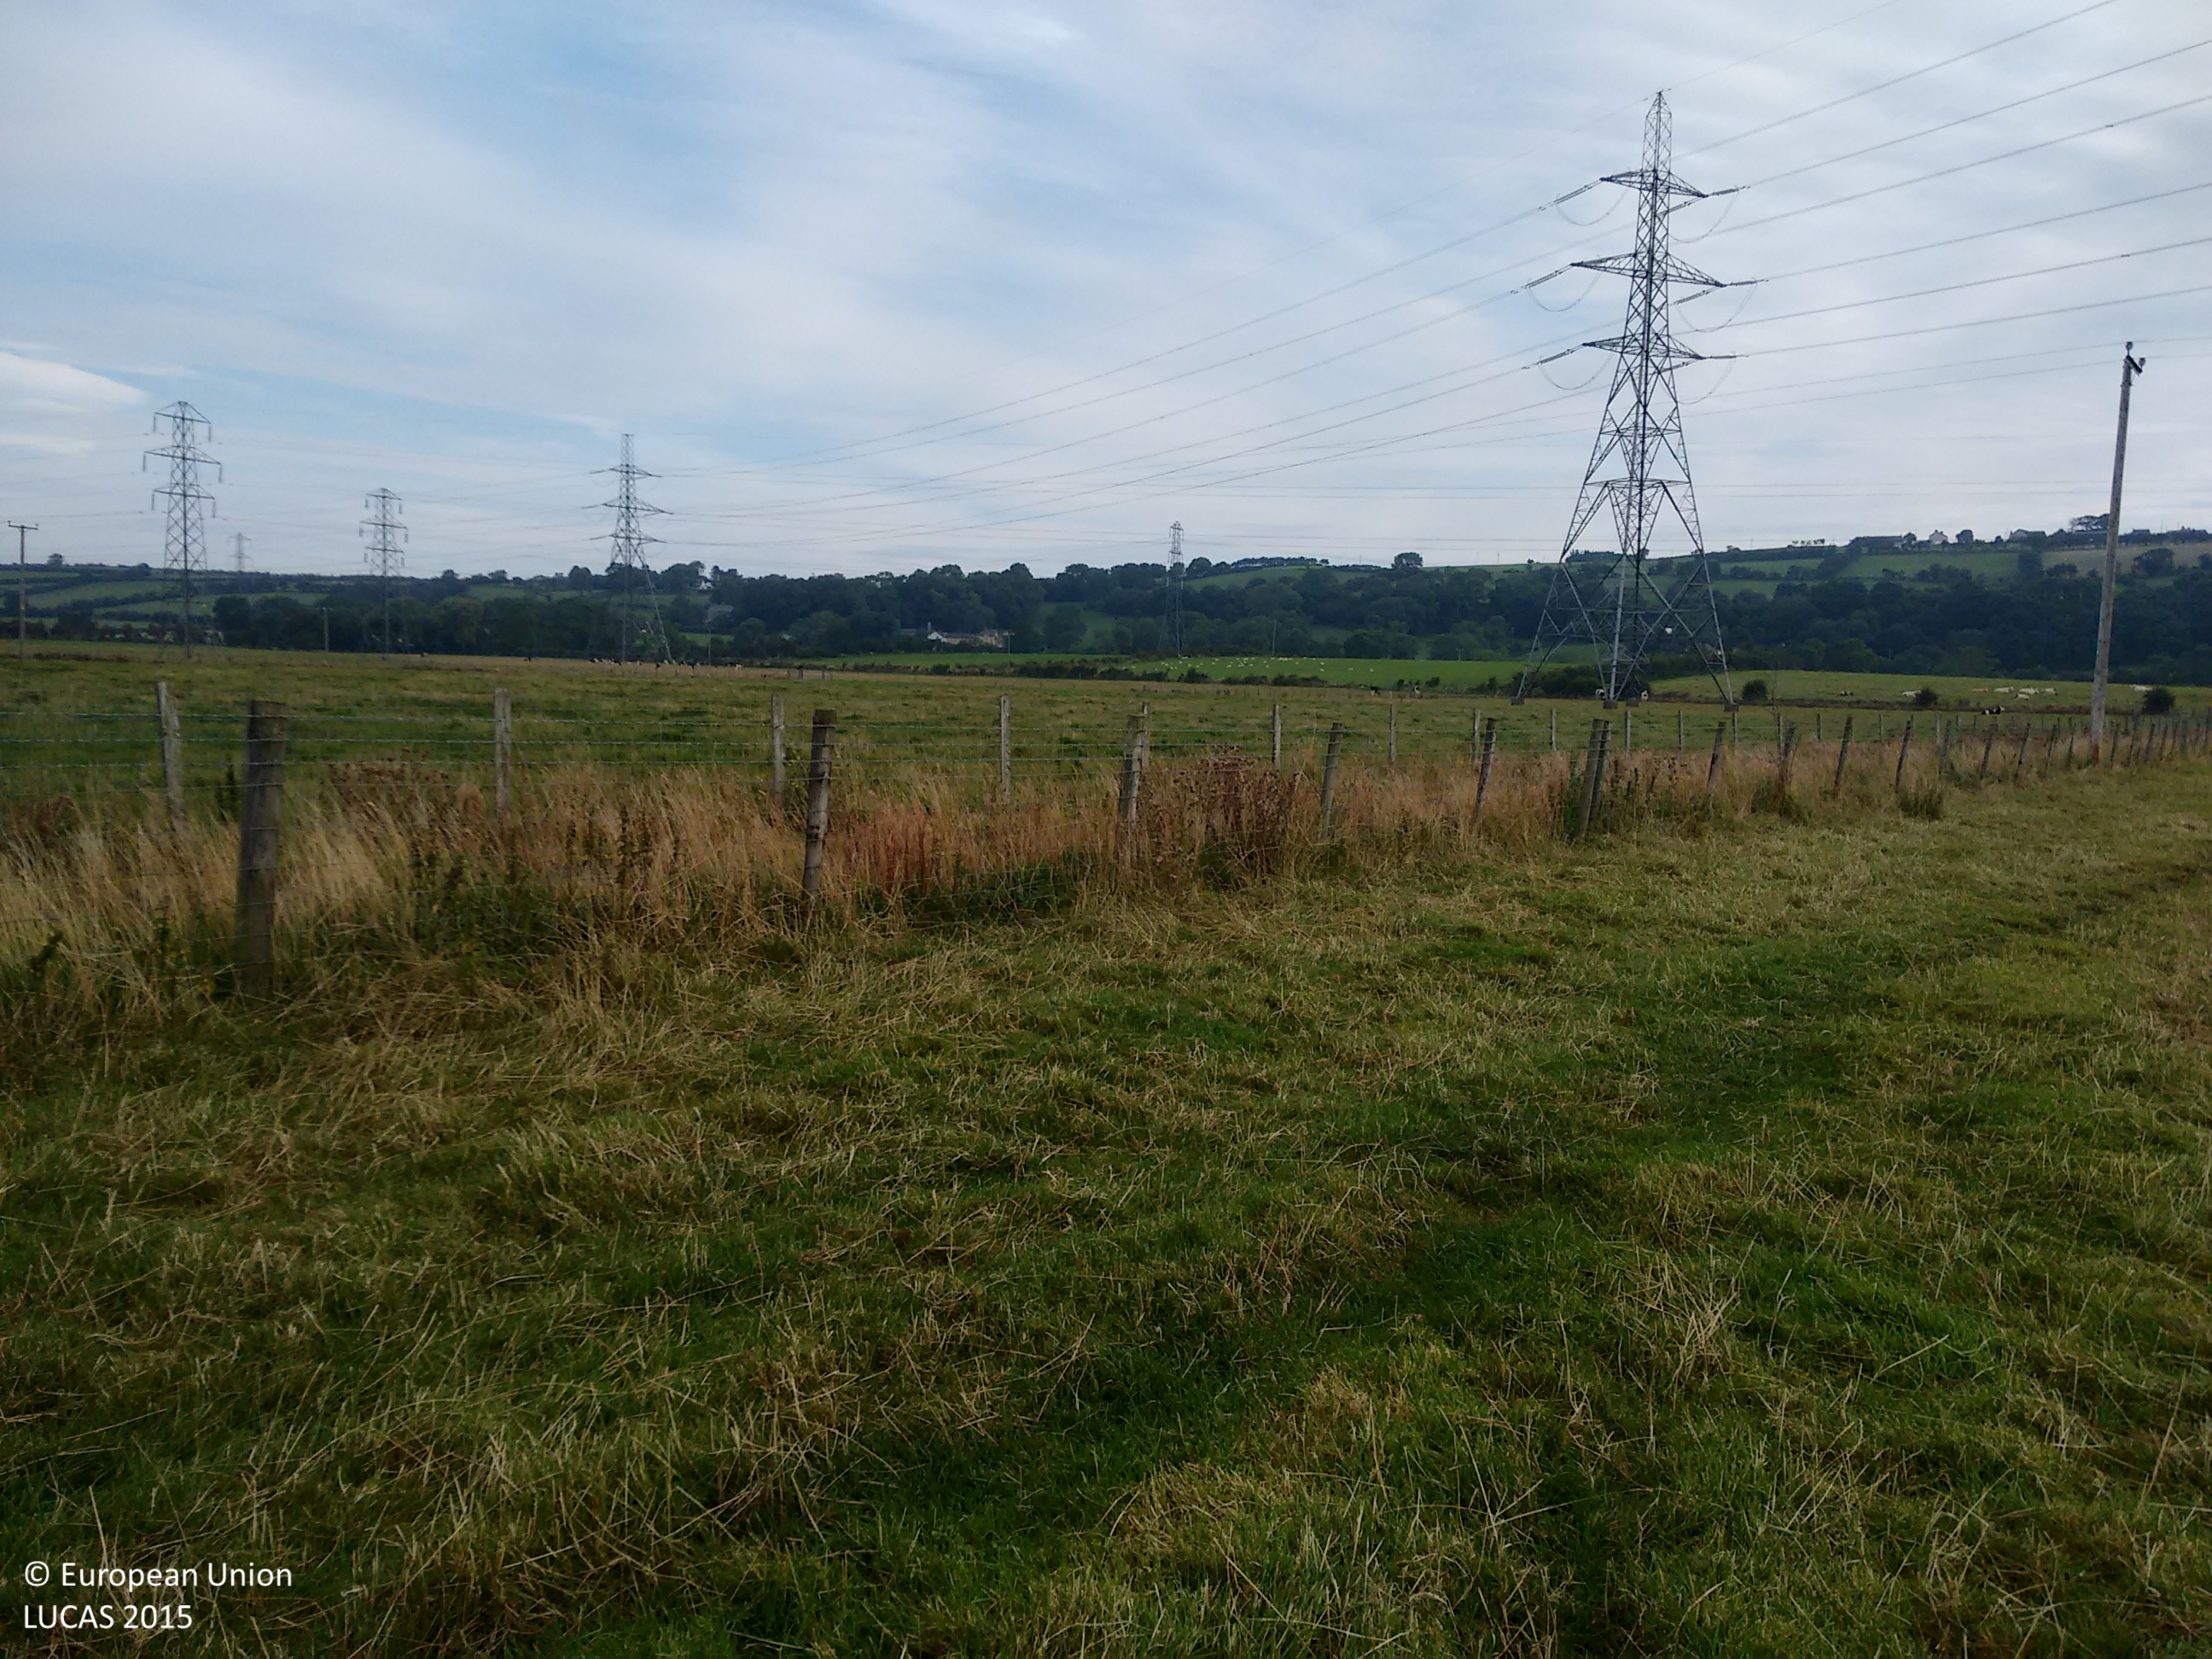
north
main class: Grassland
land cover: Grassland without tree/shrub cover
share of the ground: > 75 %
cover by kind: herbaceous plants 100 %
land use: Agriculture (excluding fallow land and kitchen gardens)
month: September
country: GB
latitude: 54.8212
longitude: -5.7435
